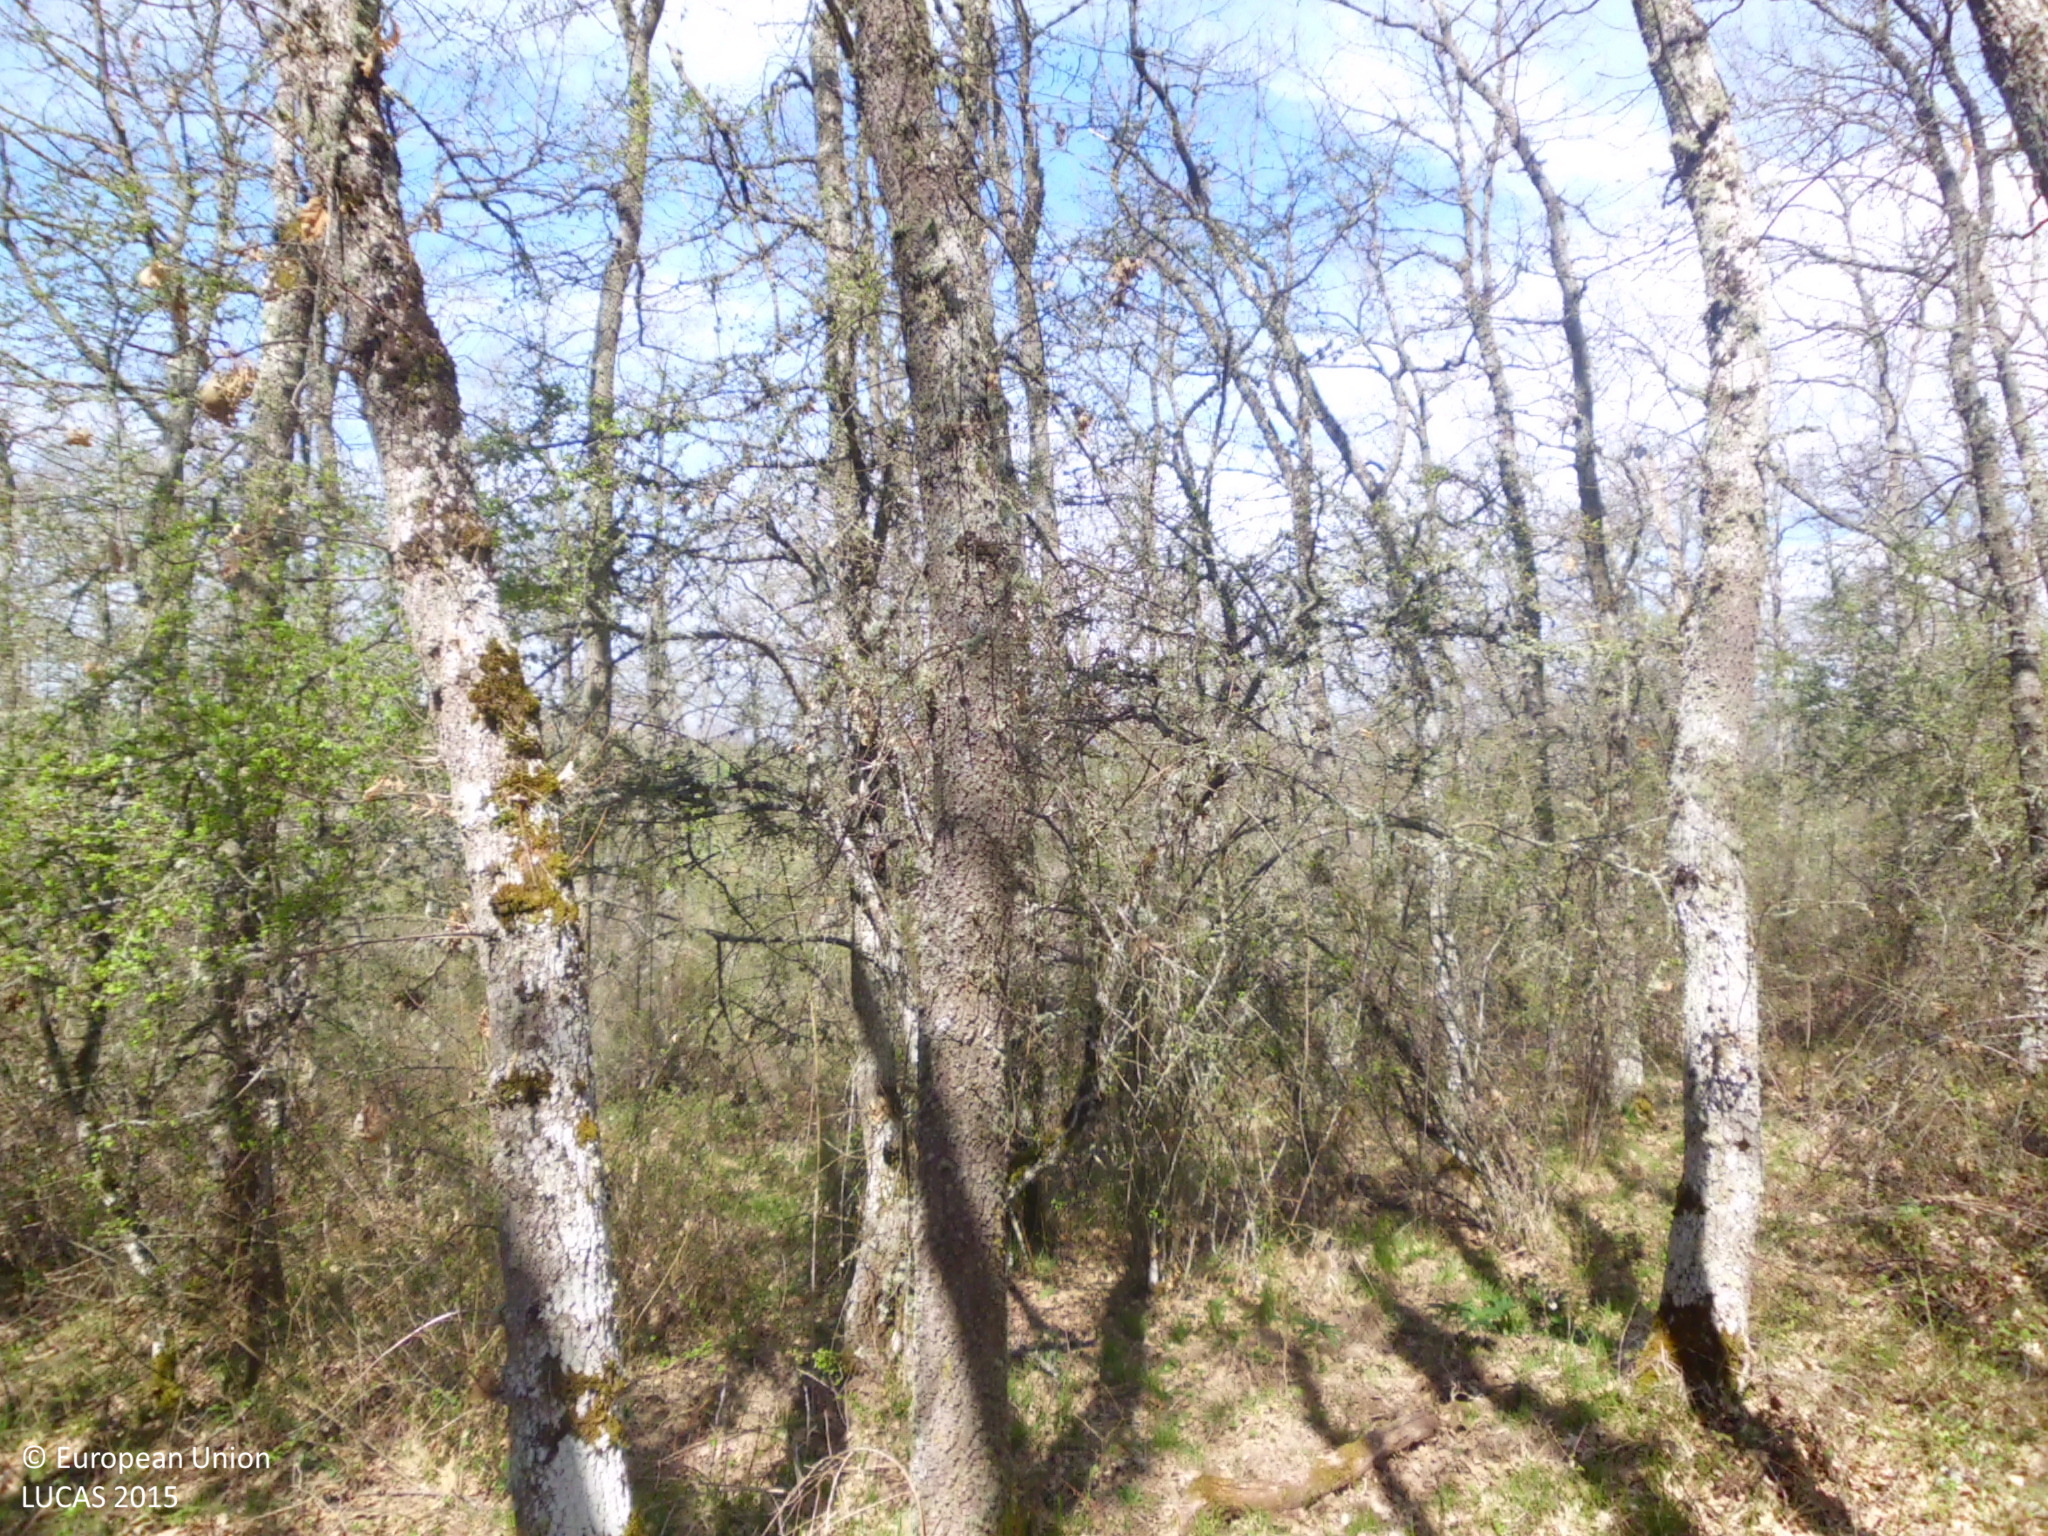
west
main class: Woodland
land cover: Broadleaved woodland
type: acidophilous oak and oak-birch forest
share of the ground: > 75 %
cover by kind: broadleaved forest trees 95 %, herbaceous plants 5 %
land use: Semi-natural and natural areas not in use
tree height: > 5 m
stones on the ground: < 10 %
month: April
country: ES
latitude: 42.4010
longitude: -3.3844
